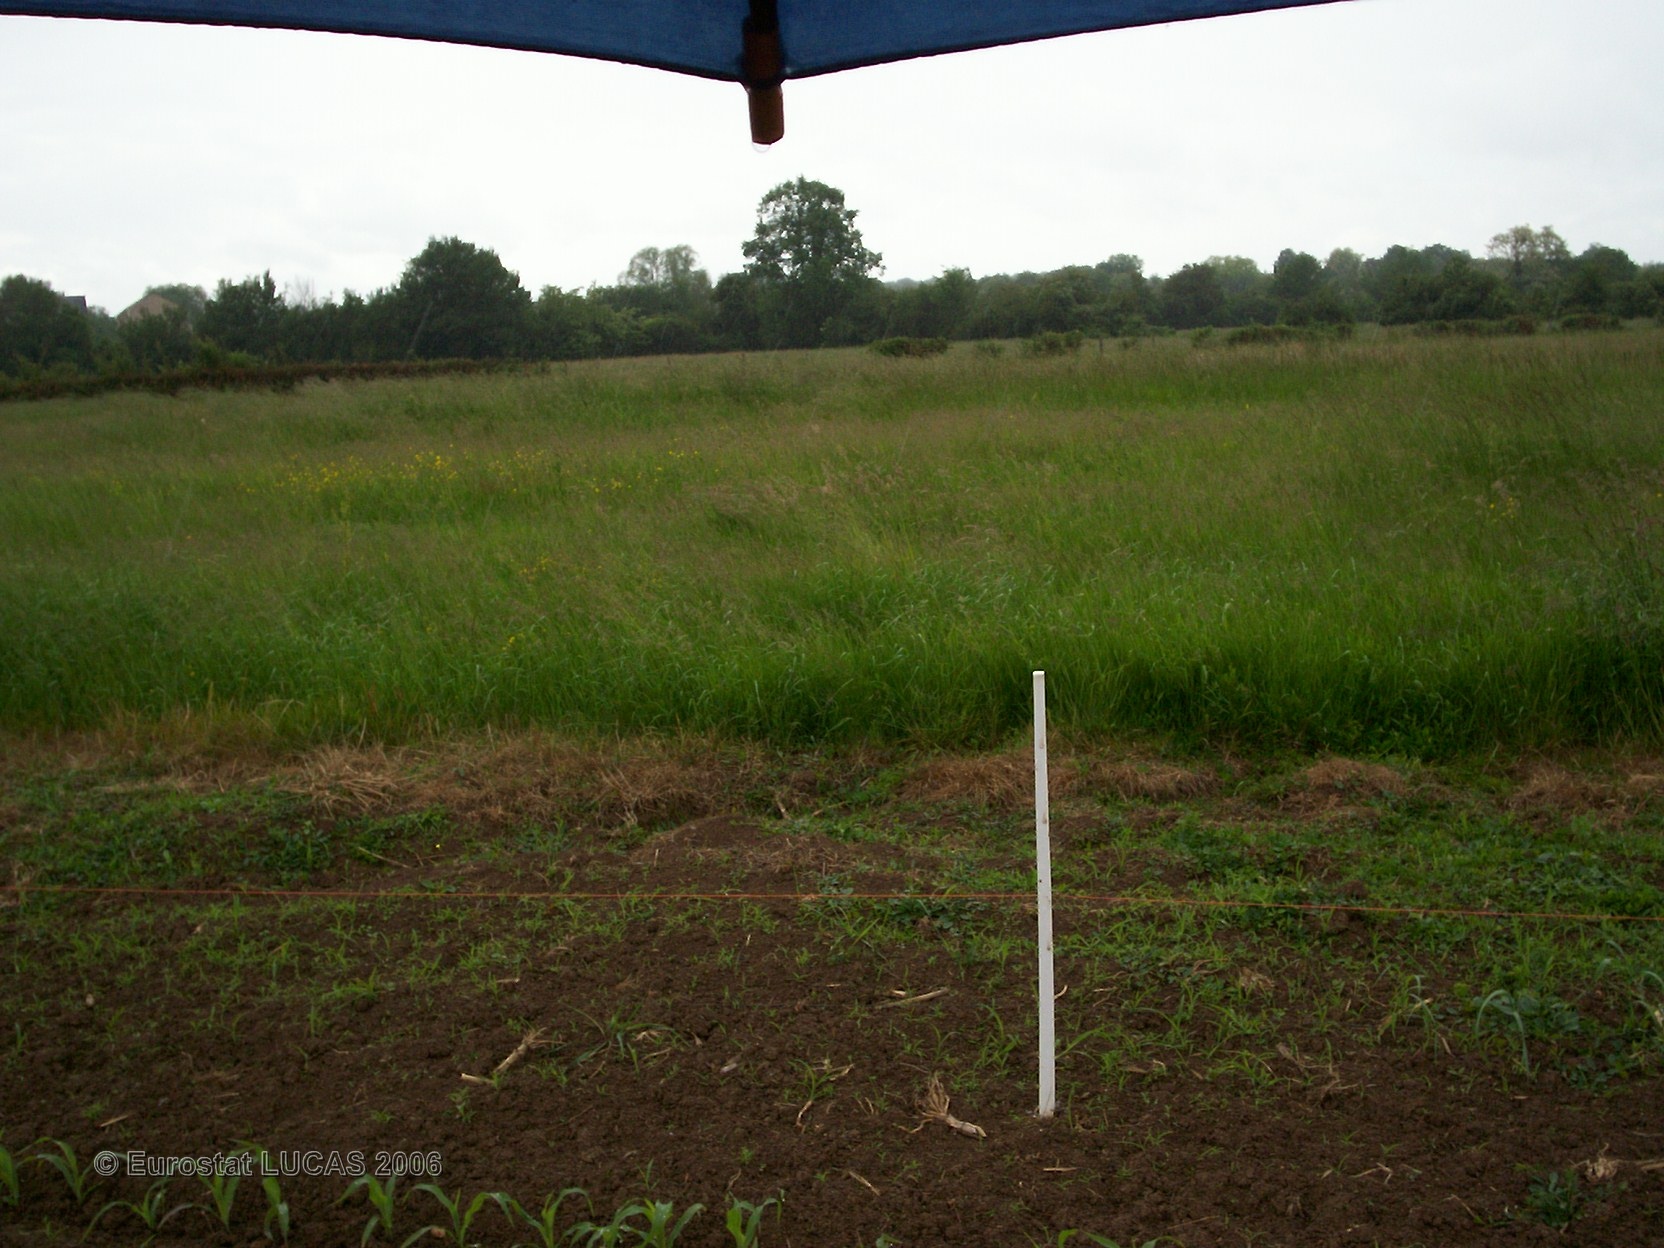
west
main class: Cropland
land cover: Maize
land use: Agriculture (excluding fallow land and kitchen gardens)
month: May
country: FR
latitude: 47.1872
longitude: 2.9874
